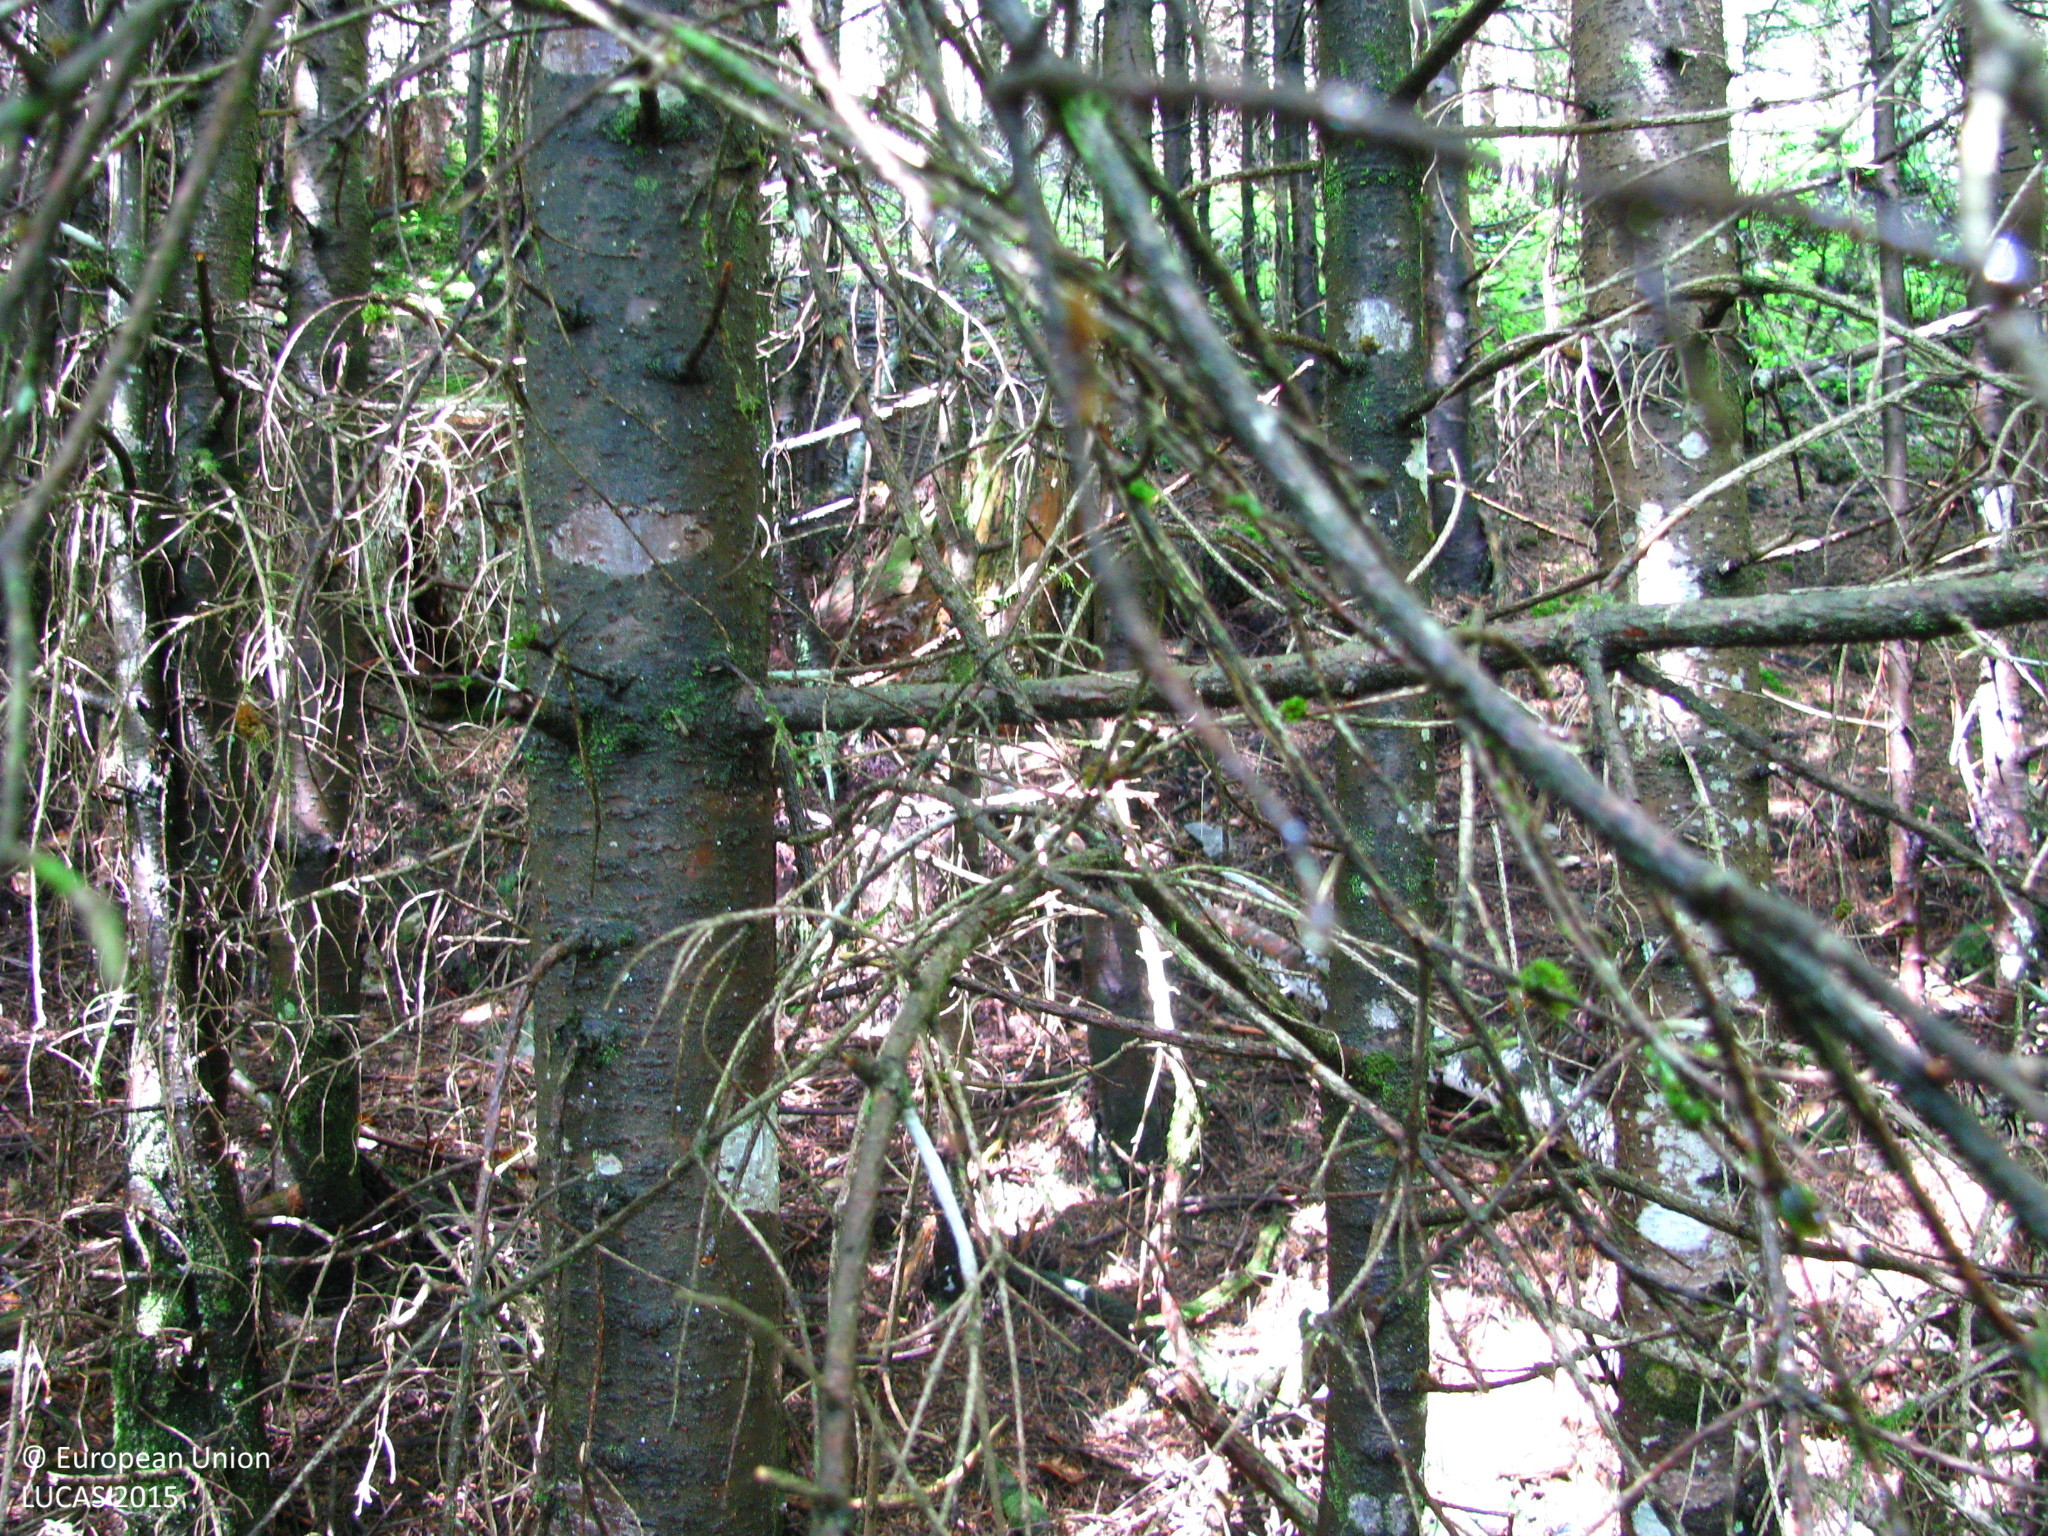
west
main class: Woodland
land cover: Other coniferous woodland
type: alpine coniferous forest
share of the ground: > 75 %
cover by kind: coniferous forest trees 90 %, broadleaved forest trees 5 %, herbaceous plants 5 %
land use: Forestry
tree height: > 5 m
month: May
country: AT
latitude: 47.5928
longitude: 14.4543
